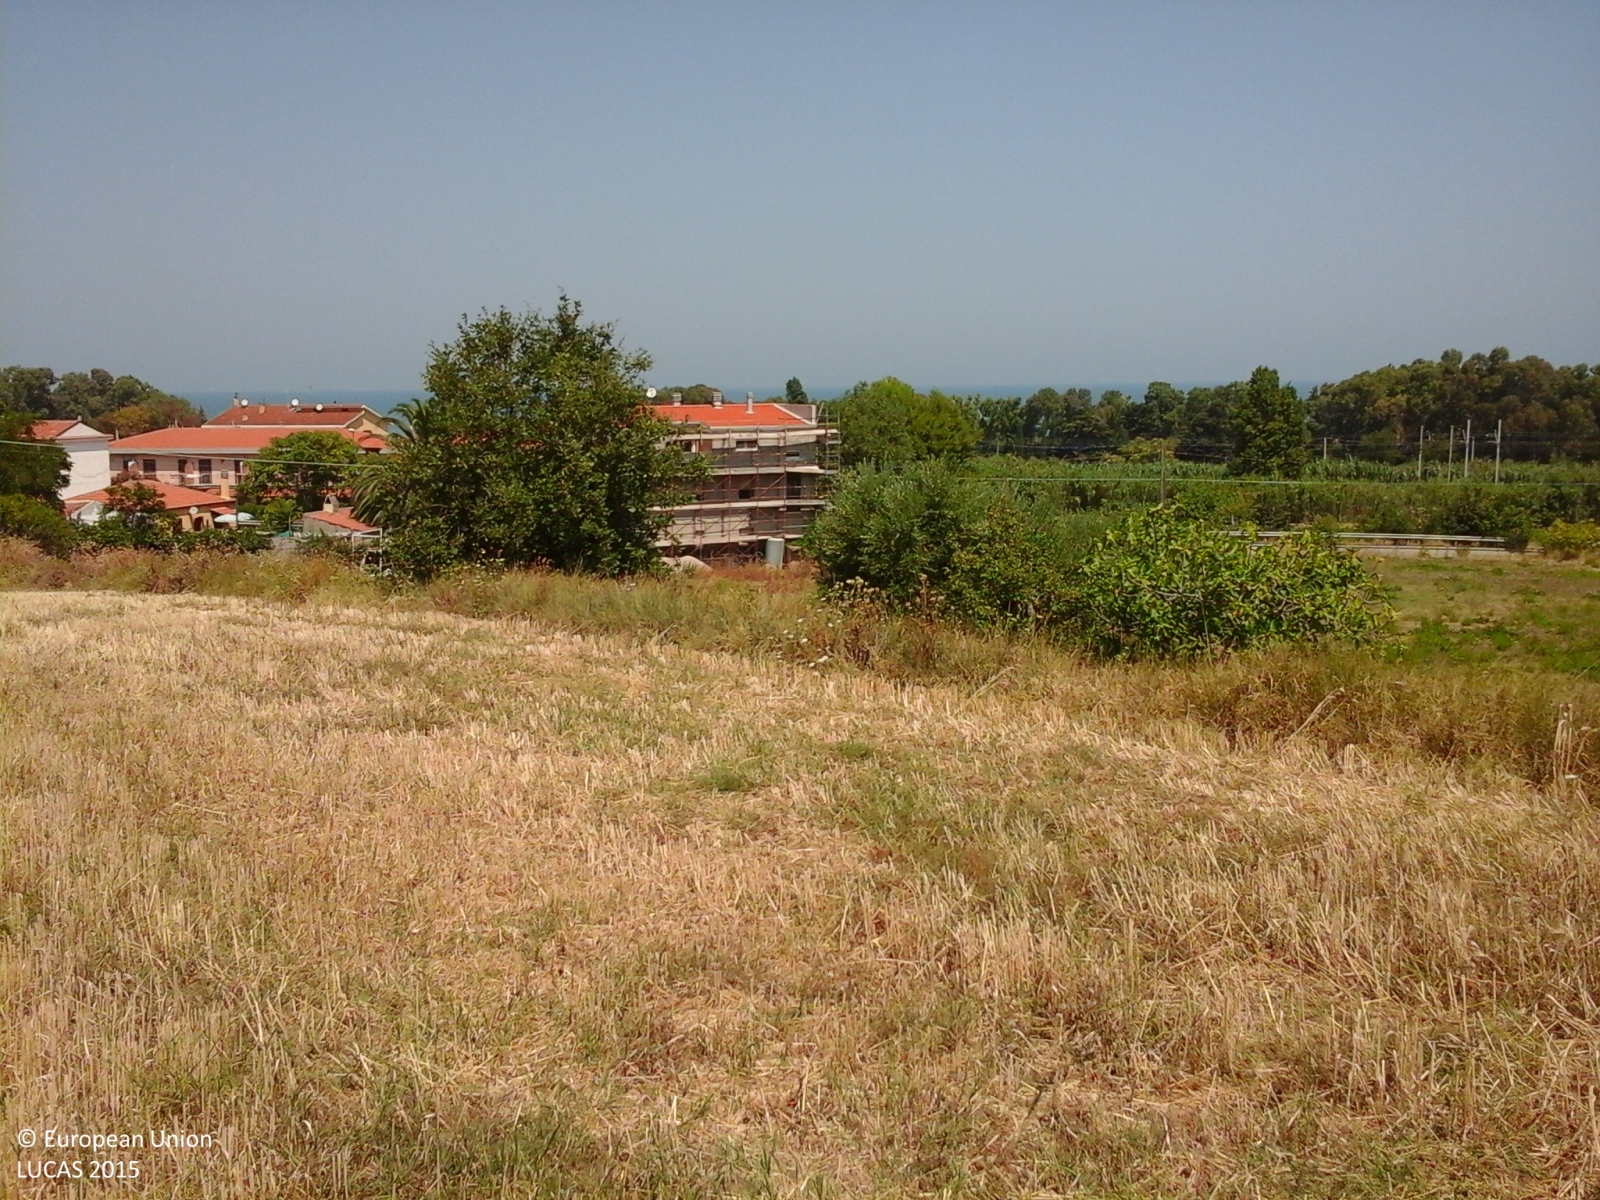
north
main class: Cropland
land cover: Durum wheat
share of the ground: > 75 %
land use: Agriculture (excluding fallow land and kitchen gardens)
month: August
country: IT
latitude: 42.0311
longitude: 14.8529
